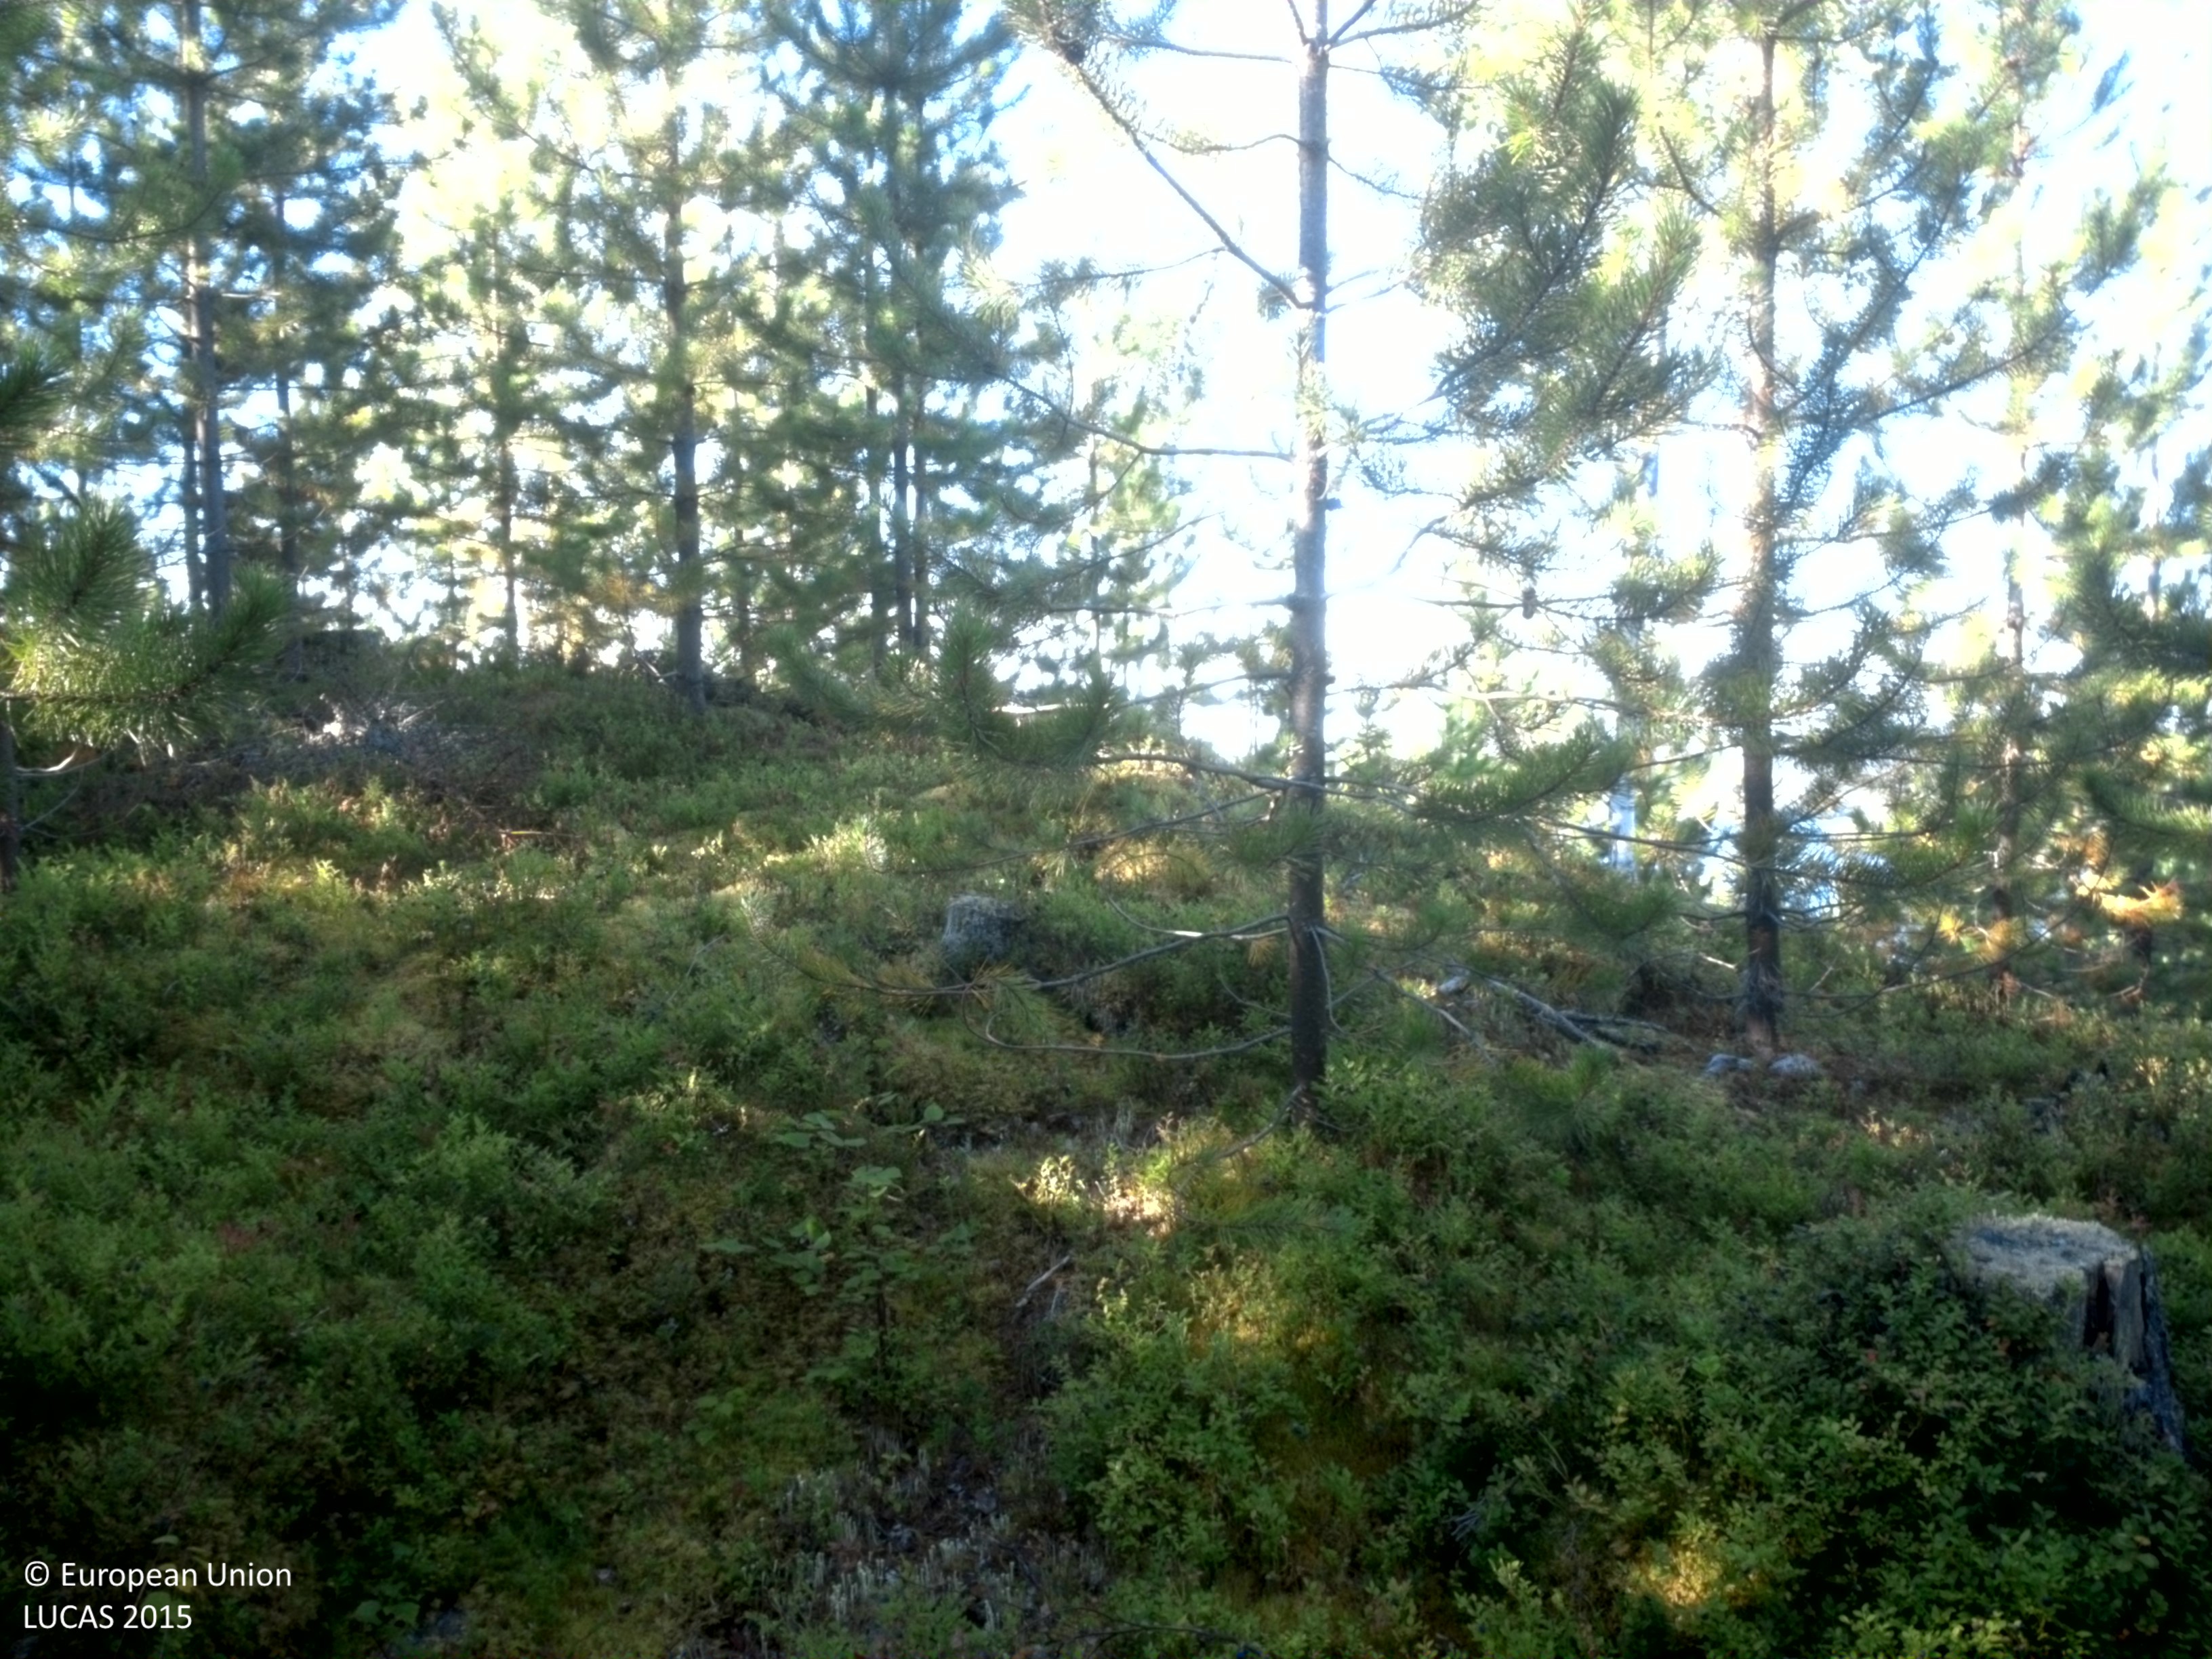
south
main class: Woodland
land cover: Pine dominated coniferous woodland
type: exotic forest
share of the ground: 50 - 75 %
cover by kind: coniferous forest trees 60 %, shrubs 30 %, lichens and mosses 10 %
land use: Forestry
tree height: > 5 m
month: September
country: SE
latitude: 64.5762
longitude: 19.0506
